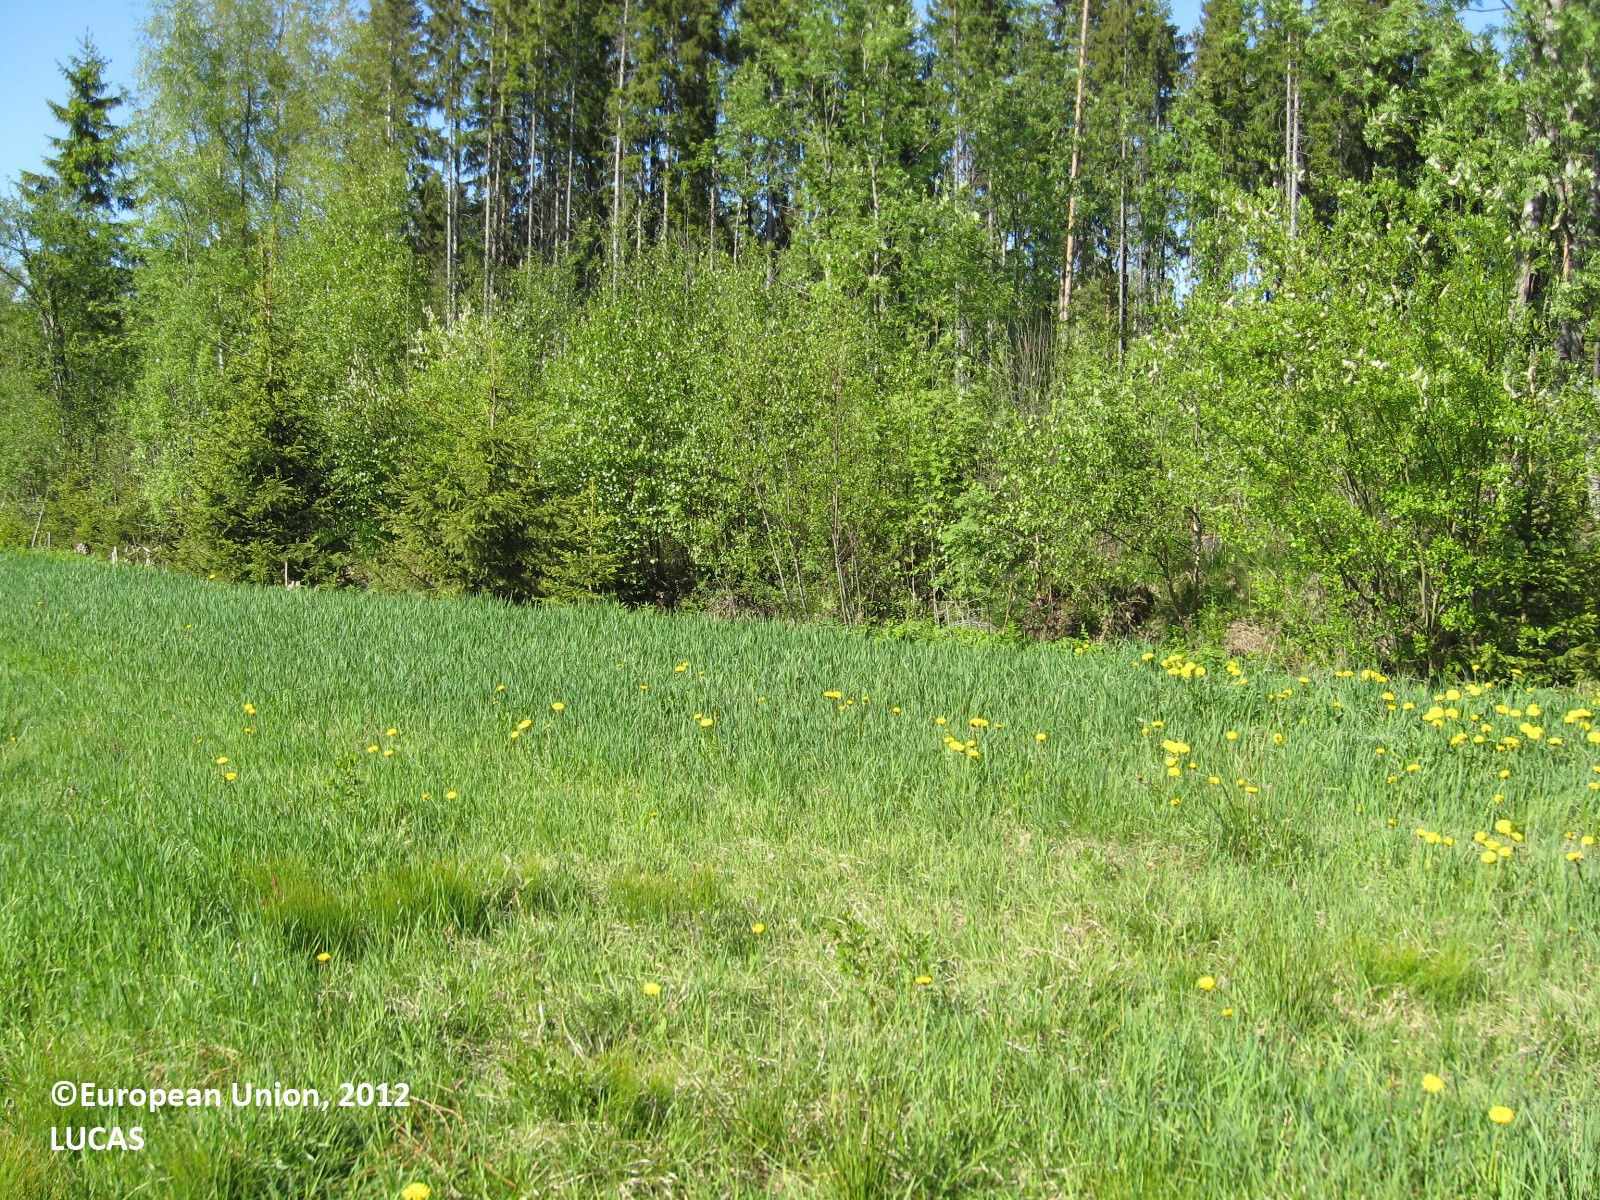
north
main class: Grassland
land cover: Grassland without tree/shrub cover
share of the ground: > 75 %
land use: Agriculture (excluding fallow land and kitchen gardens)
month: May
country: FI
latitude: 61.7686
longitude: 22.3966
